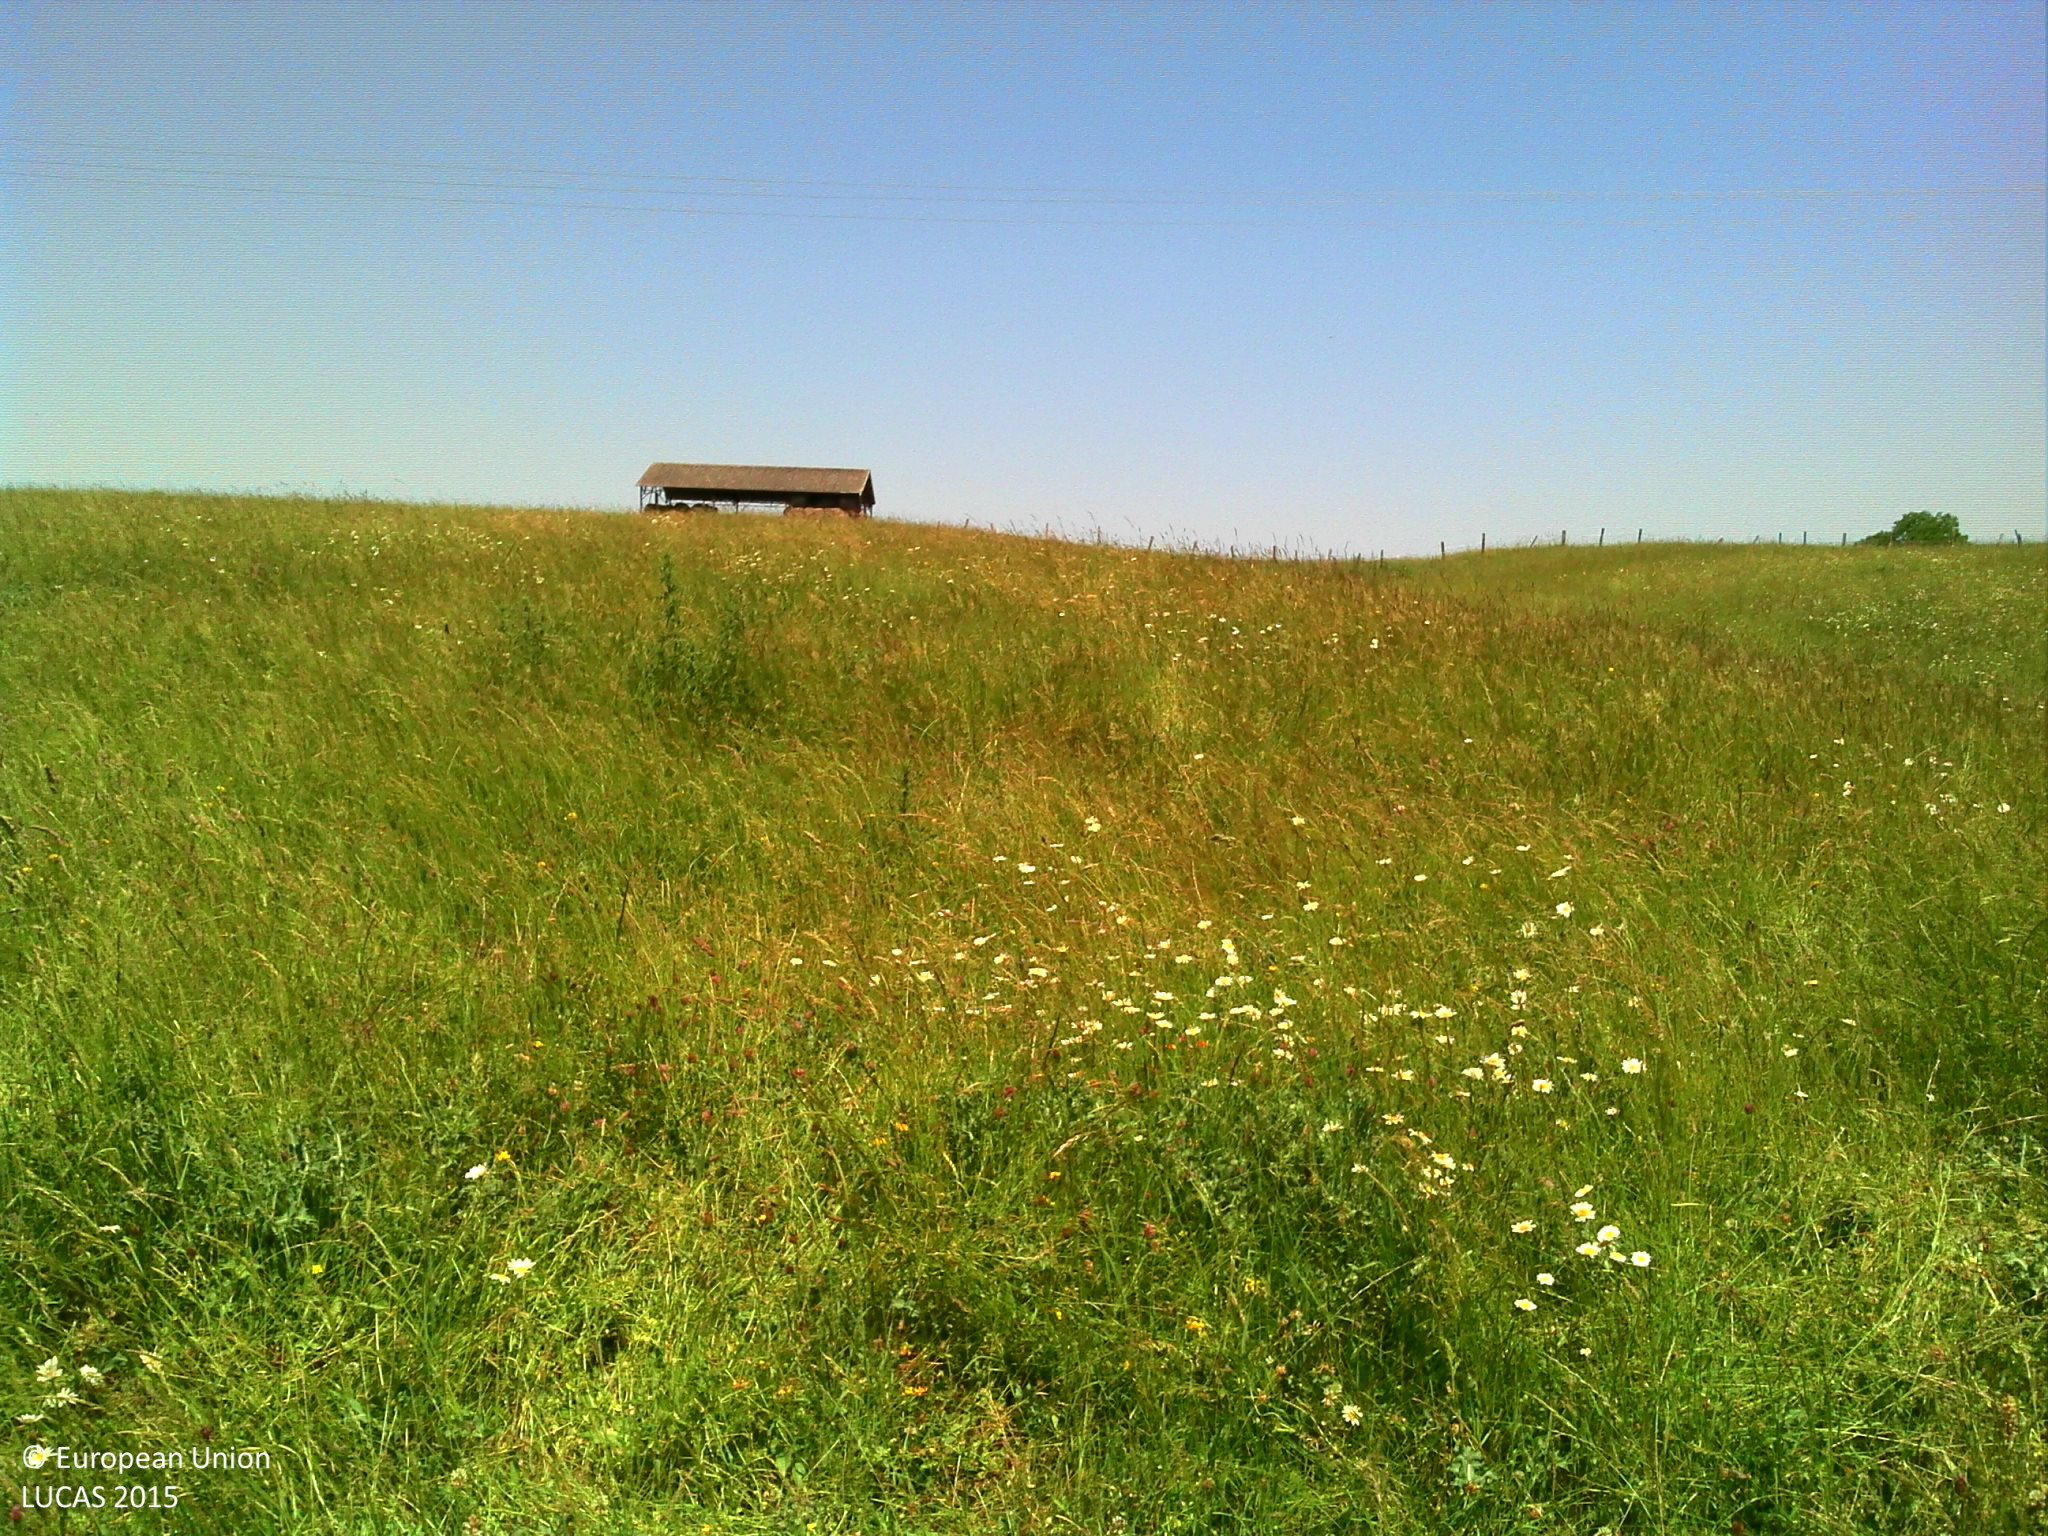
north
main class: Grassland
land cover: Grassland without tree/shrub cover
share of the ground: > 75 %
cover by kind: herbaceous plants 100 %
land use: Agriculture (excluding fallow land and kitchen gardens)
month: June
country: FR
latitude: 46.9689
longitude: 2.9638
